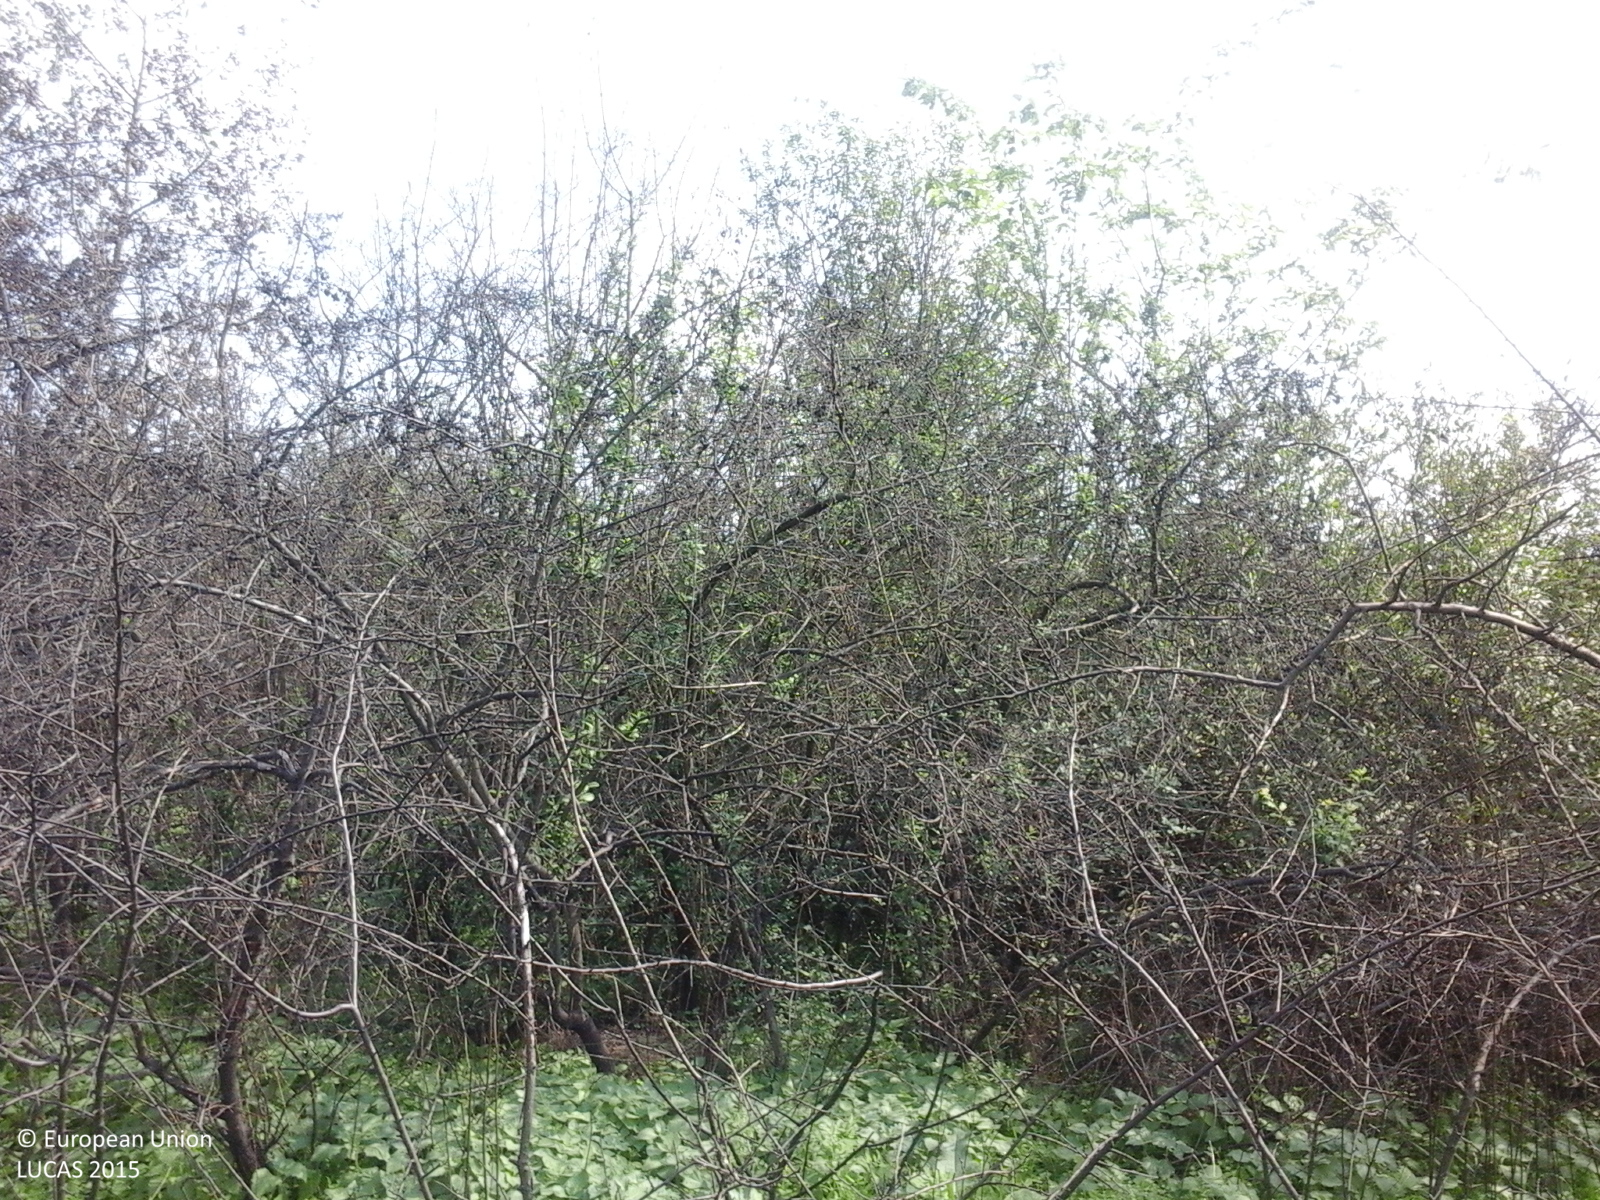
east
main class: Shrubland
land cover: Shrubland with sparse tree cover
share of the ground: > 75 %
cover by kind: shrubs 95 %, broadleaved forest trees 5 %
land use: Semi-natural and natural areas not in use
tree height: > 5 m
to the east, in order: Shrubland with sparse tree cover; Spontaneously vegetated surfaces; Tracks; Grassland with sparse tree/shrub cover; Tracks; Grassland without tree/shrub cover; Maize; Grass margins; Tracks; Grass margins; Maize; Grassland without tree/shrub cover
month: September
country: RO
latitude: 44.9780
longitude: 23.2283
